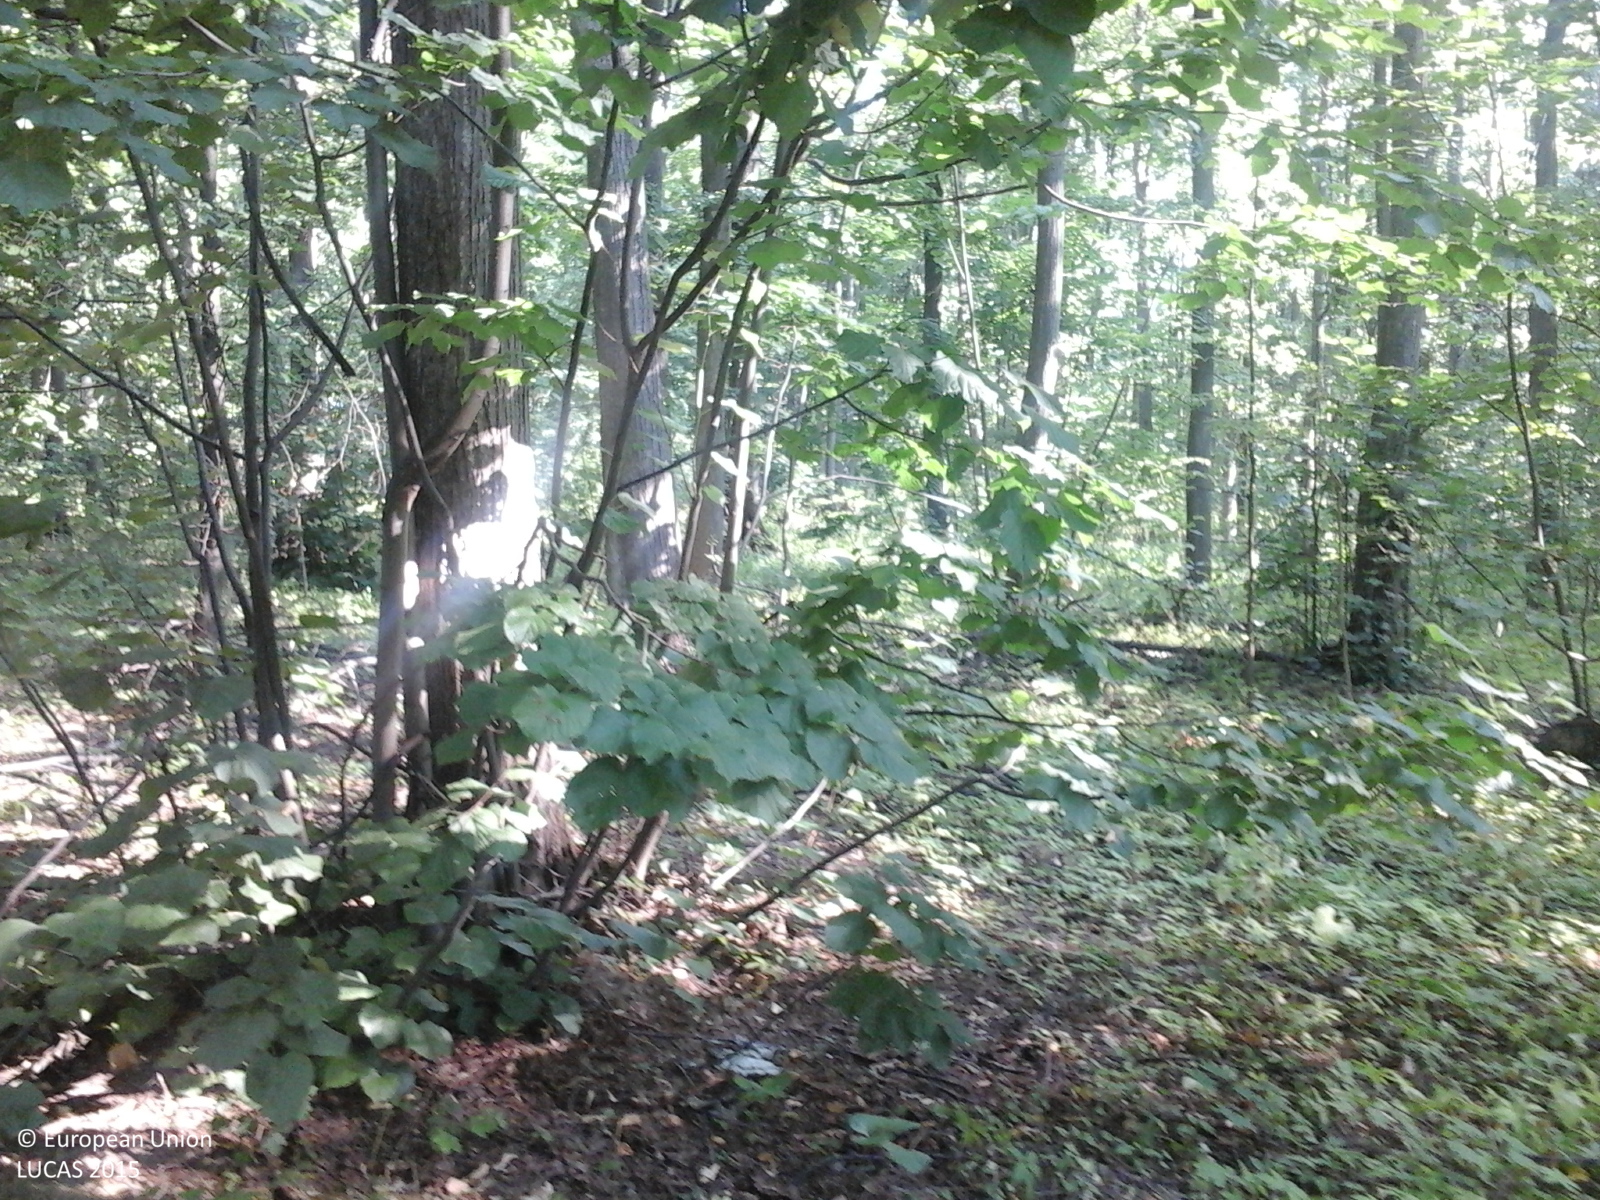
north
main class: Woodland
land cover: Broadleaved woodland
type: mesophytic deciduous forest
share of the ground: > 75 %
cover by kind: broadleaved forest trees 90 %, herbaceous plants 10 %
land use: Forestry
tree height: > 5 m
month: July
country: RO
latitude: 46.0540
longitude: 27.2778
